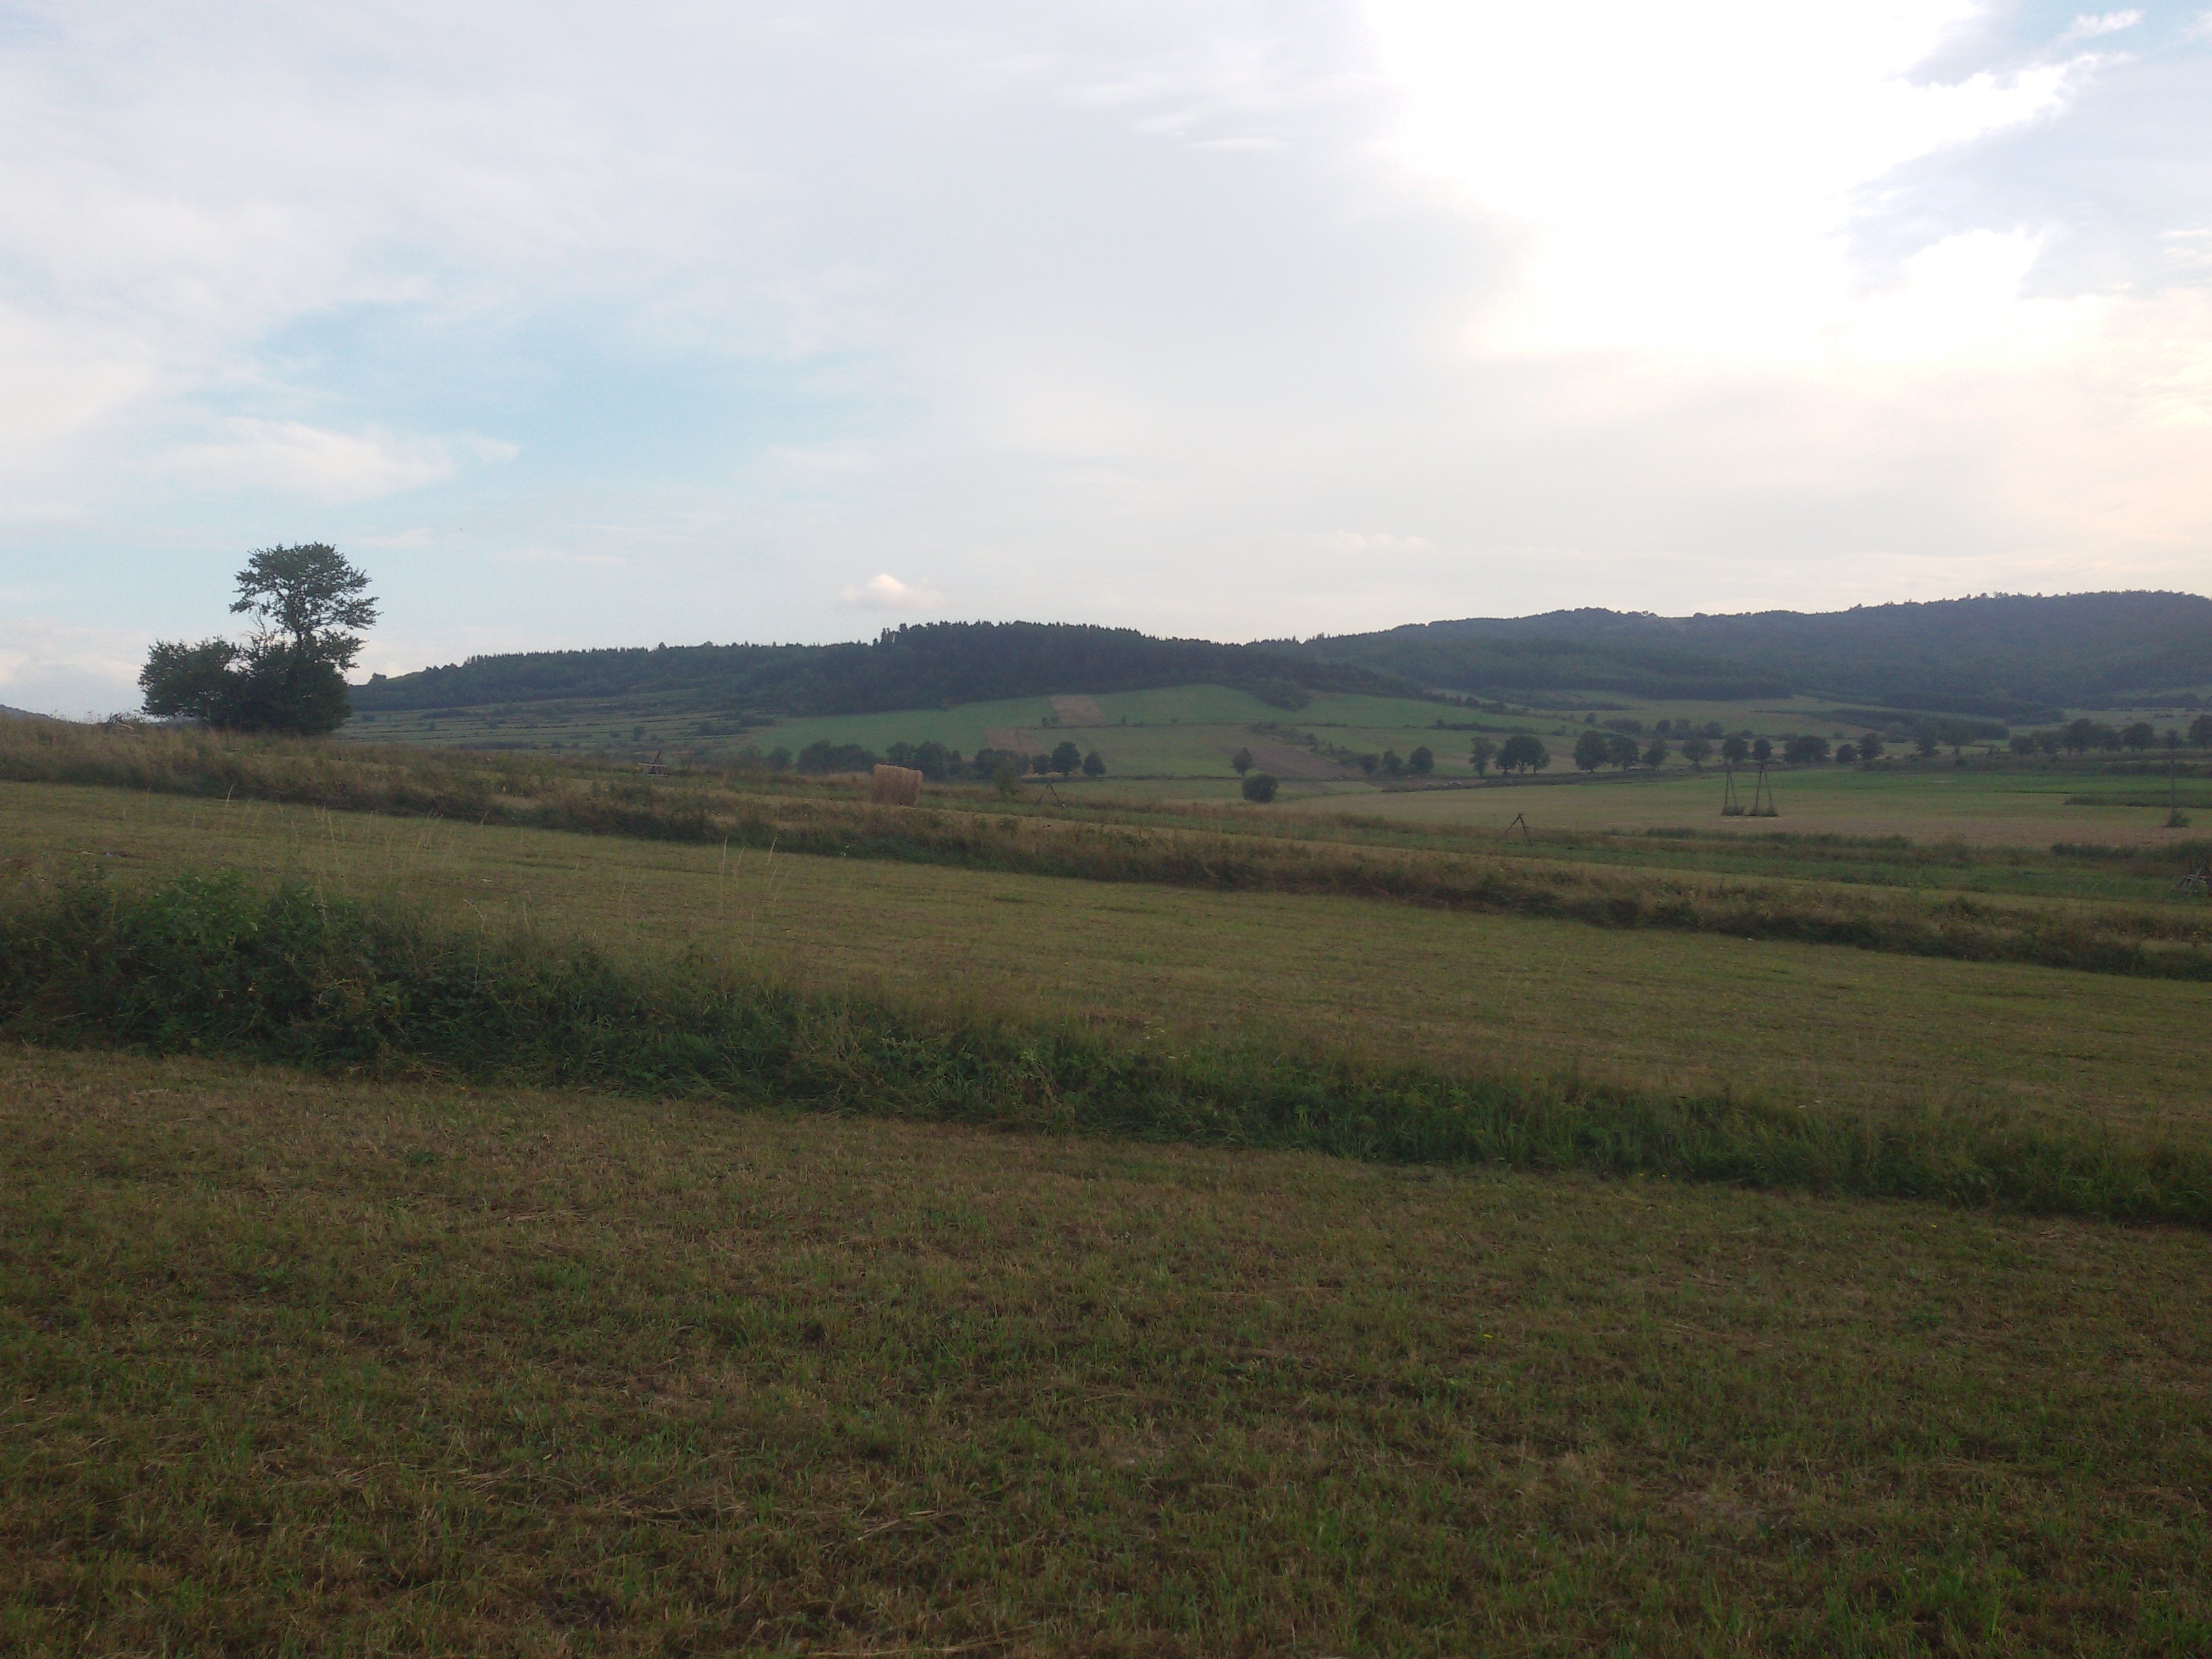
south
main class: Grassland
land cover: Grassland without tree/shrub cover
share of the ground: > 75 %
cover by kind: herbaceous plants 100 %
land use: Agriculture (excluding fallow land and kitchen gardens)
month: September
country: PL
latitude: 49.6187
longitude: 21.4966
